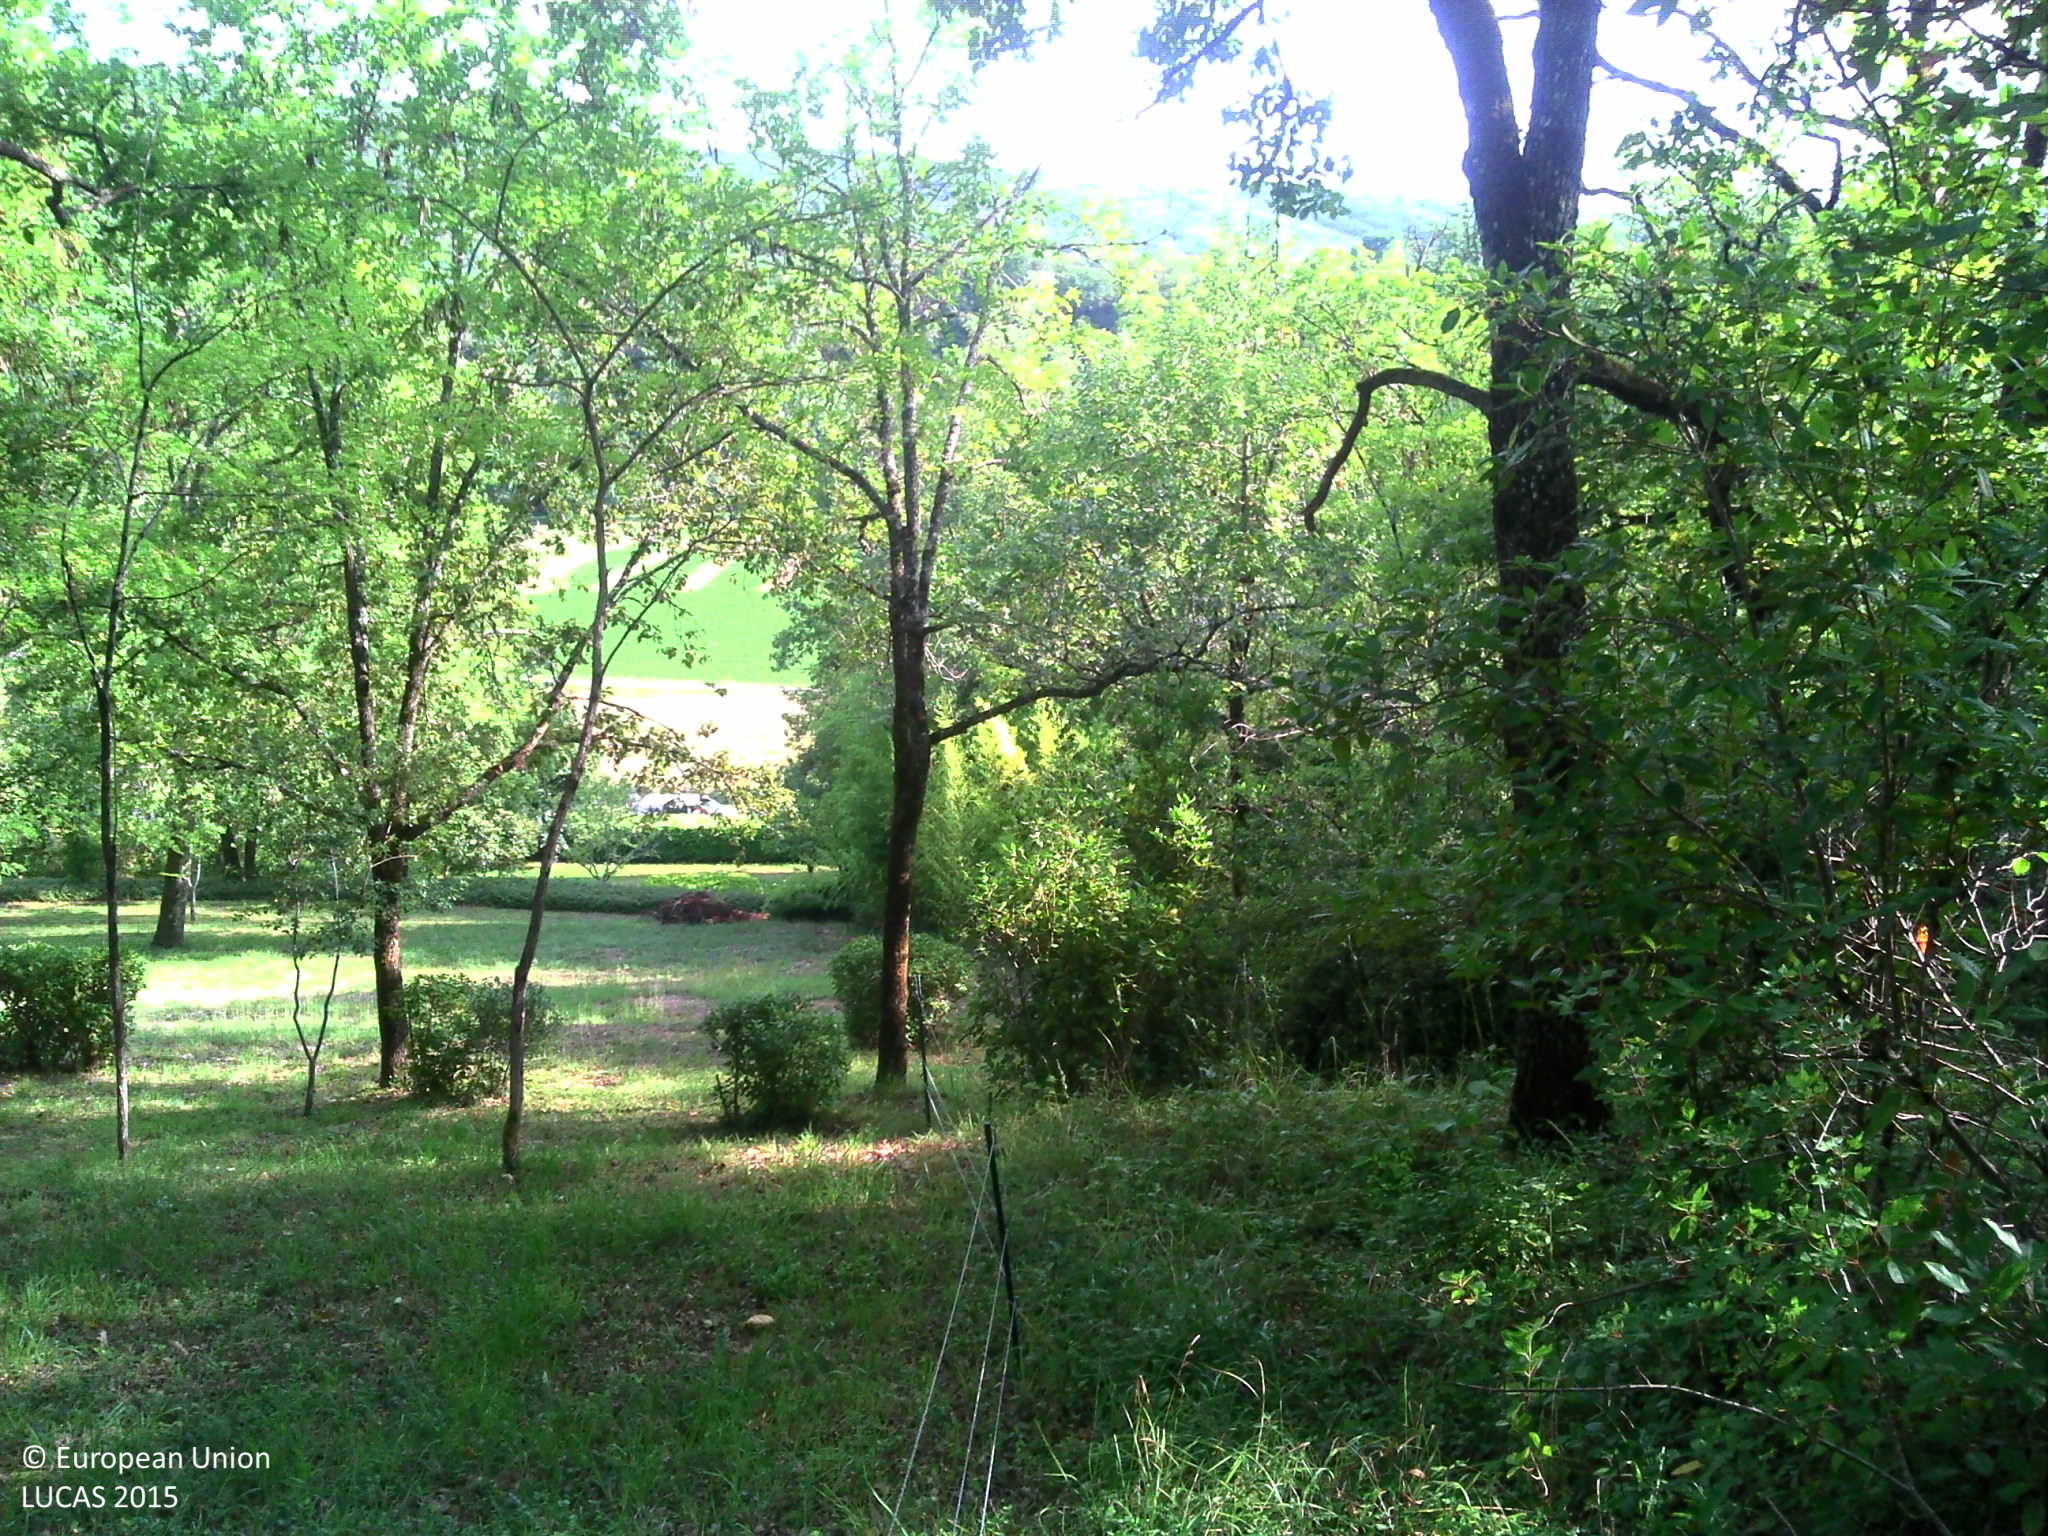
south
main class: Woodland
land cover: Broadleaved woodland
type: thermophilous deciduous forest
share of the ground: > 75 %
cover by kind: broadleaved forest trees 80 %, shrubs 10 %, herbaceous plants 10 %
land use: Residential
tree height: > 5 m
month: August
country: FR
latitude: 44.4887
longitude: 1.2577
